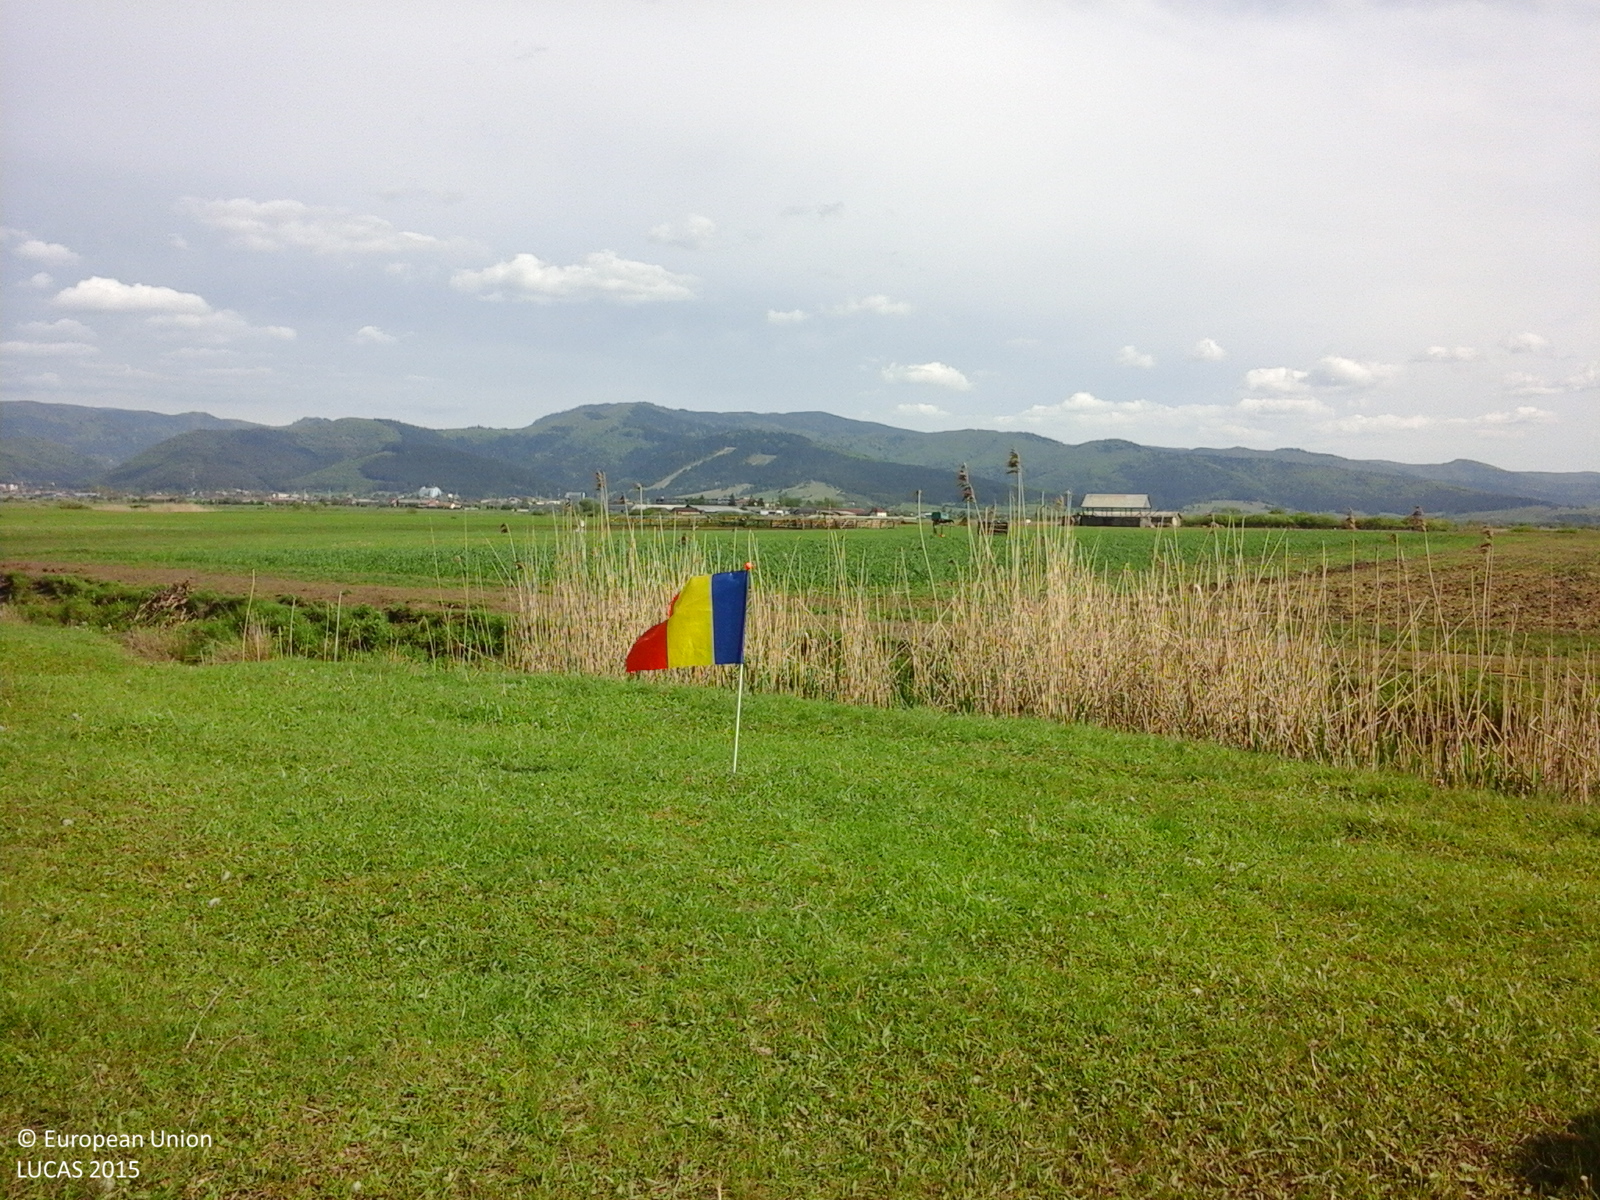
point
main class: Grassland
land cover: Grassland without tree/shrub cover
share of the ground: > 75 %
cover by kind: herbaceous plants 100 %
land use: Agriculture (excluding fallow land and kitchen gardens)
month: May
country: RO
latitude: 45.8690
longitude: 26.1317
